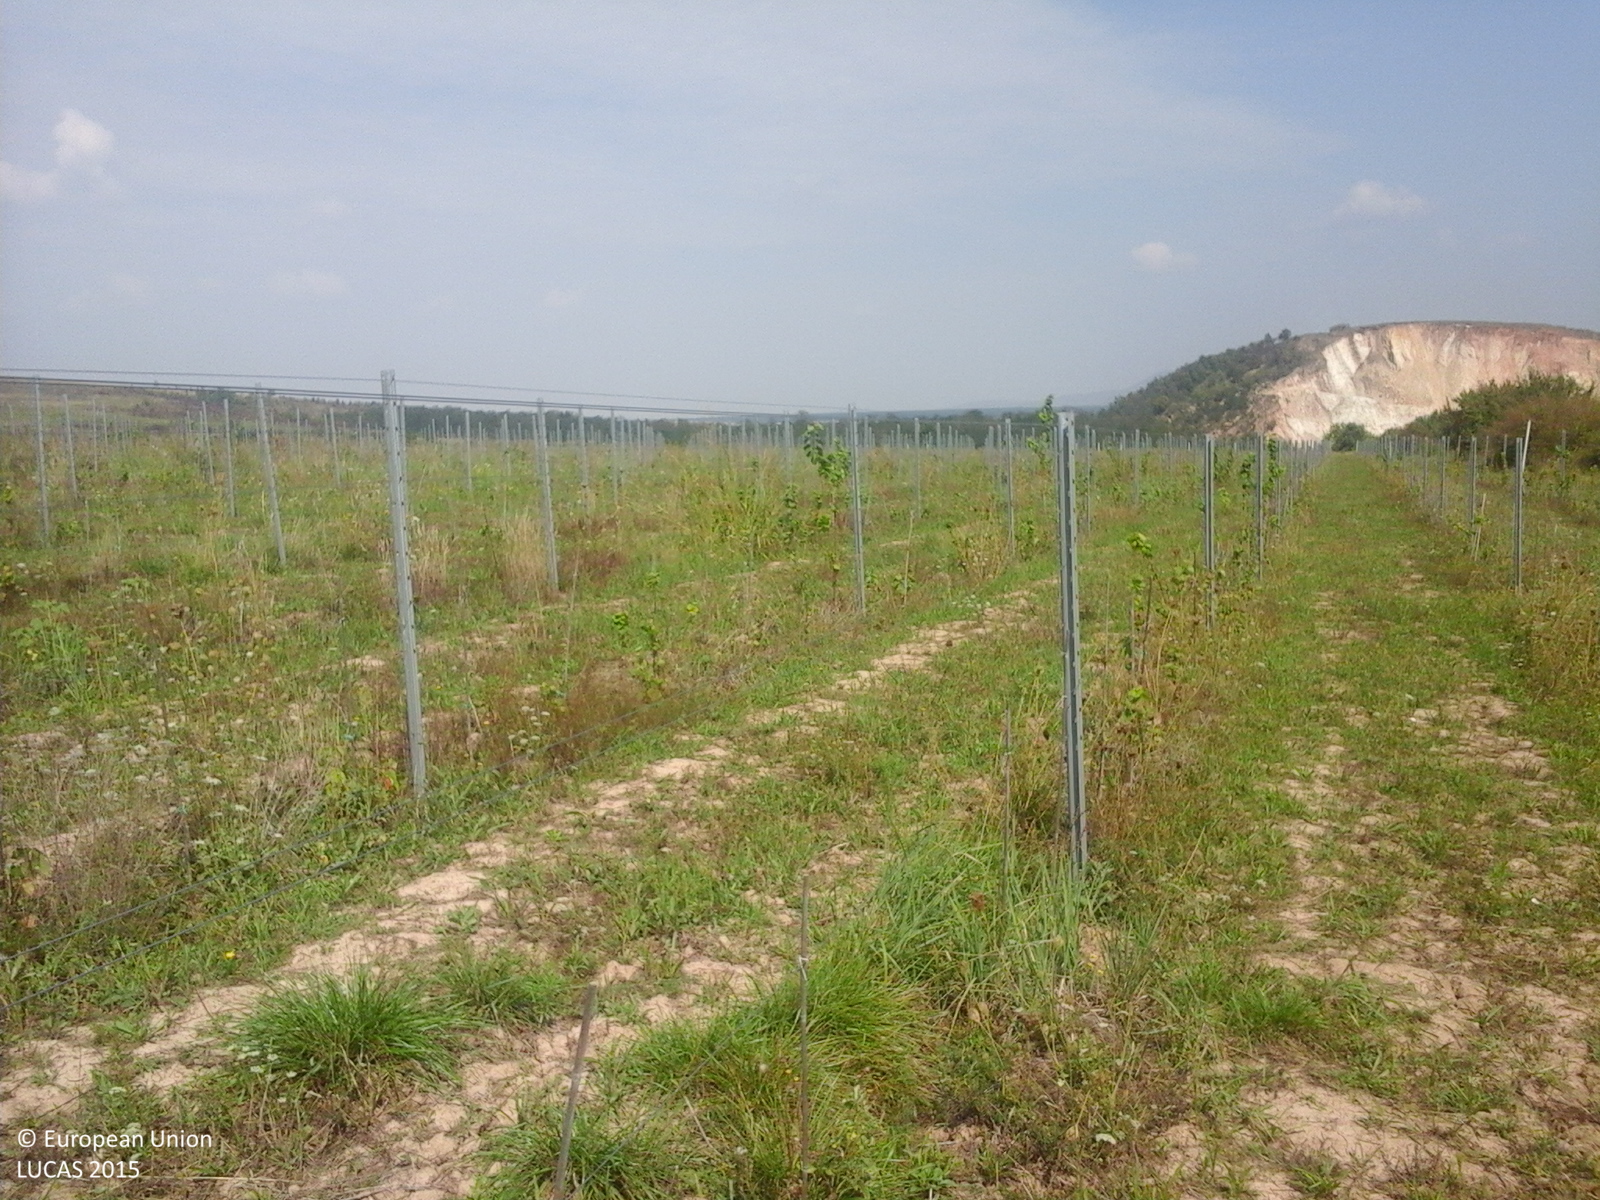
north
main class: Cropland
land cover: Vineyards
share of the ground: 10 - 25 %
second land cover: Grassland without tree/shrub cover
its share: > 75 %
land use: Agriculture (excluding fallow land and kitchen gardens)
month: August
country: RO
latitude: 46.2708
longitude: 21.8622
